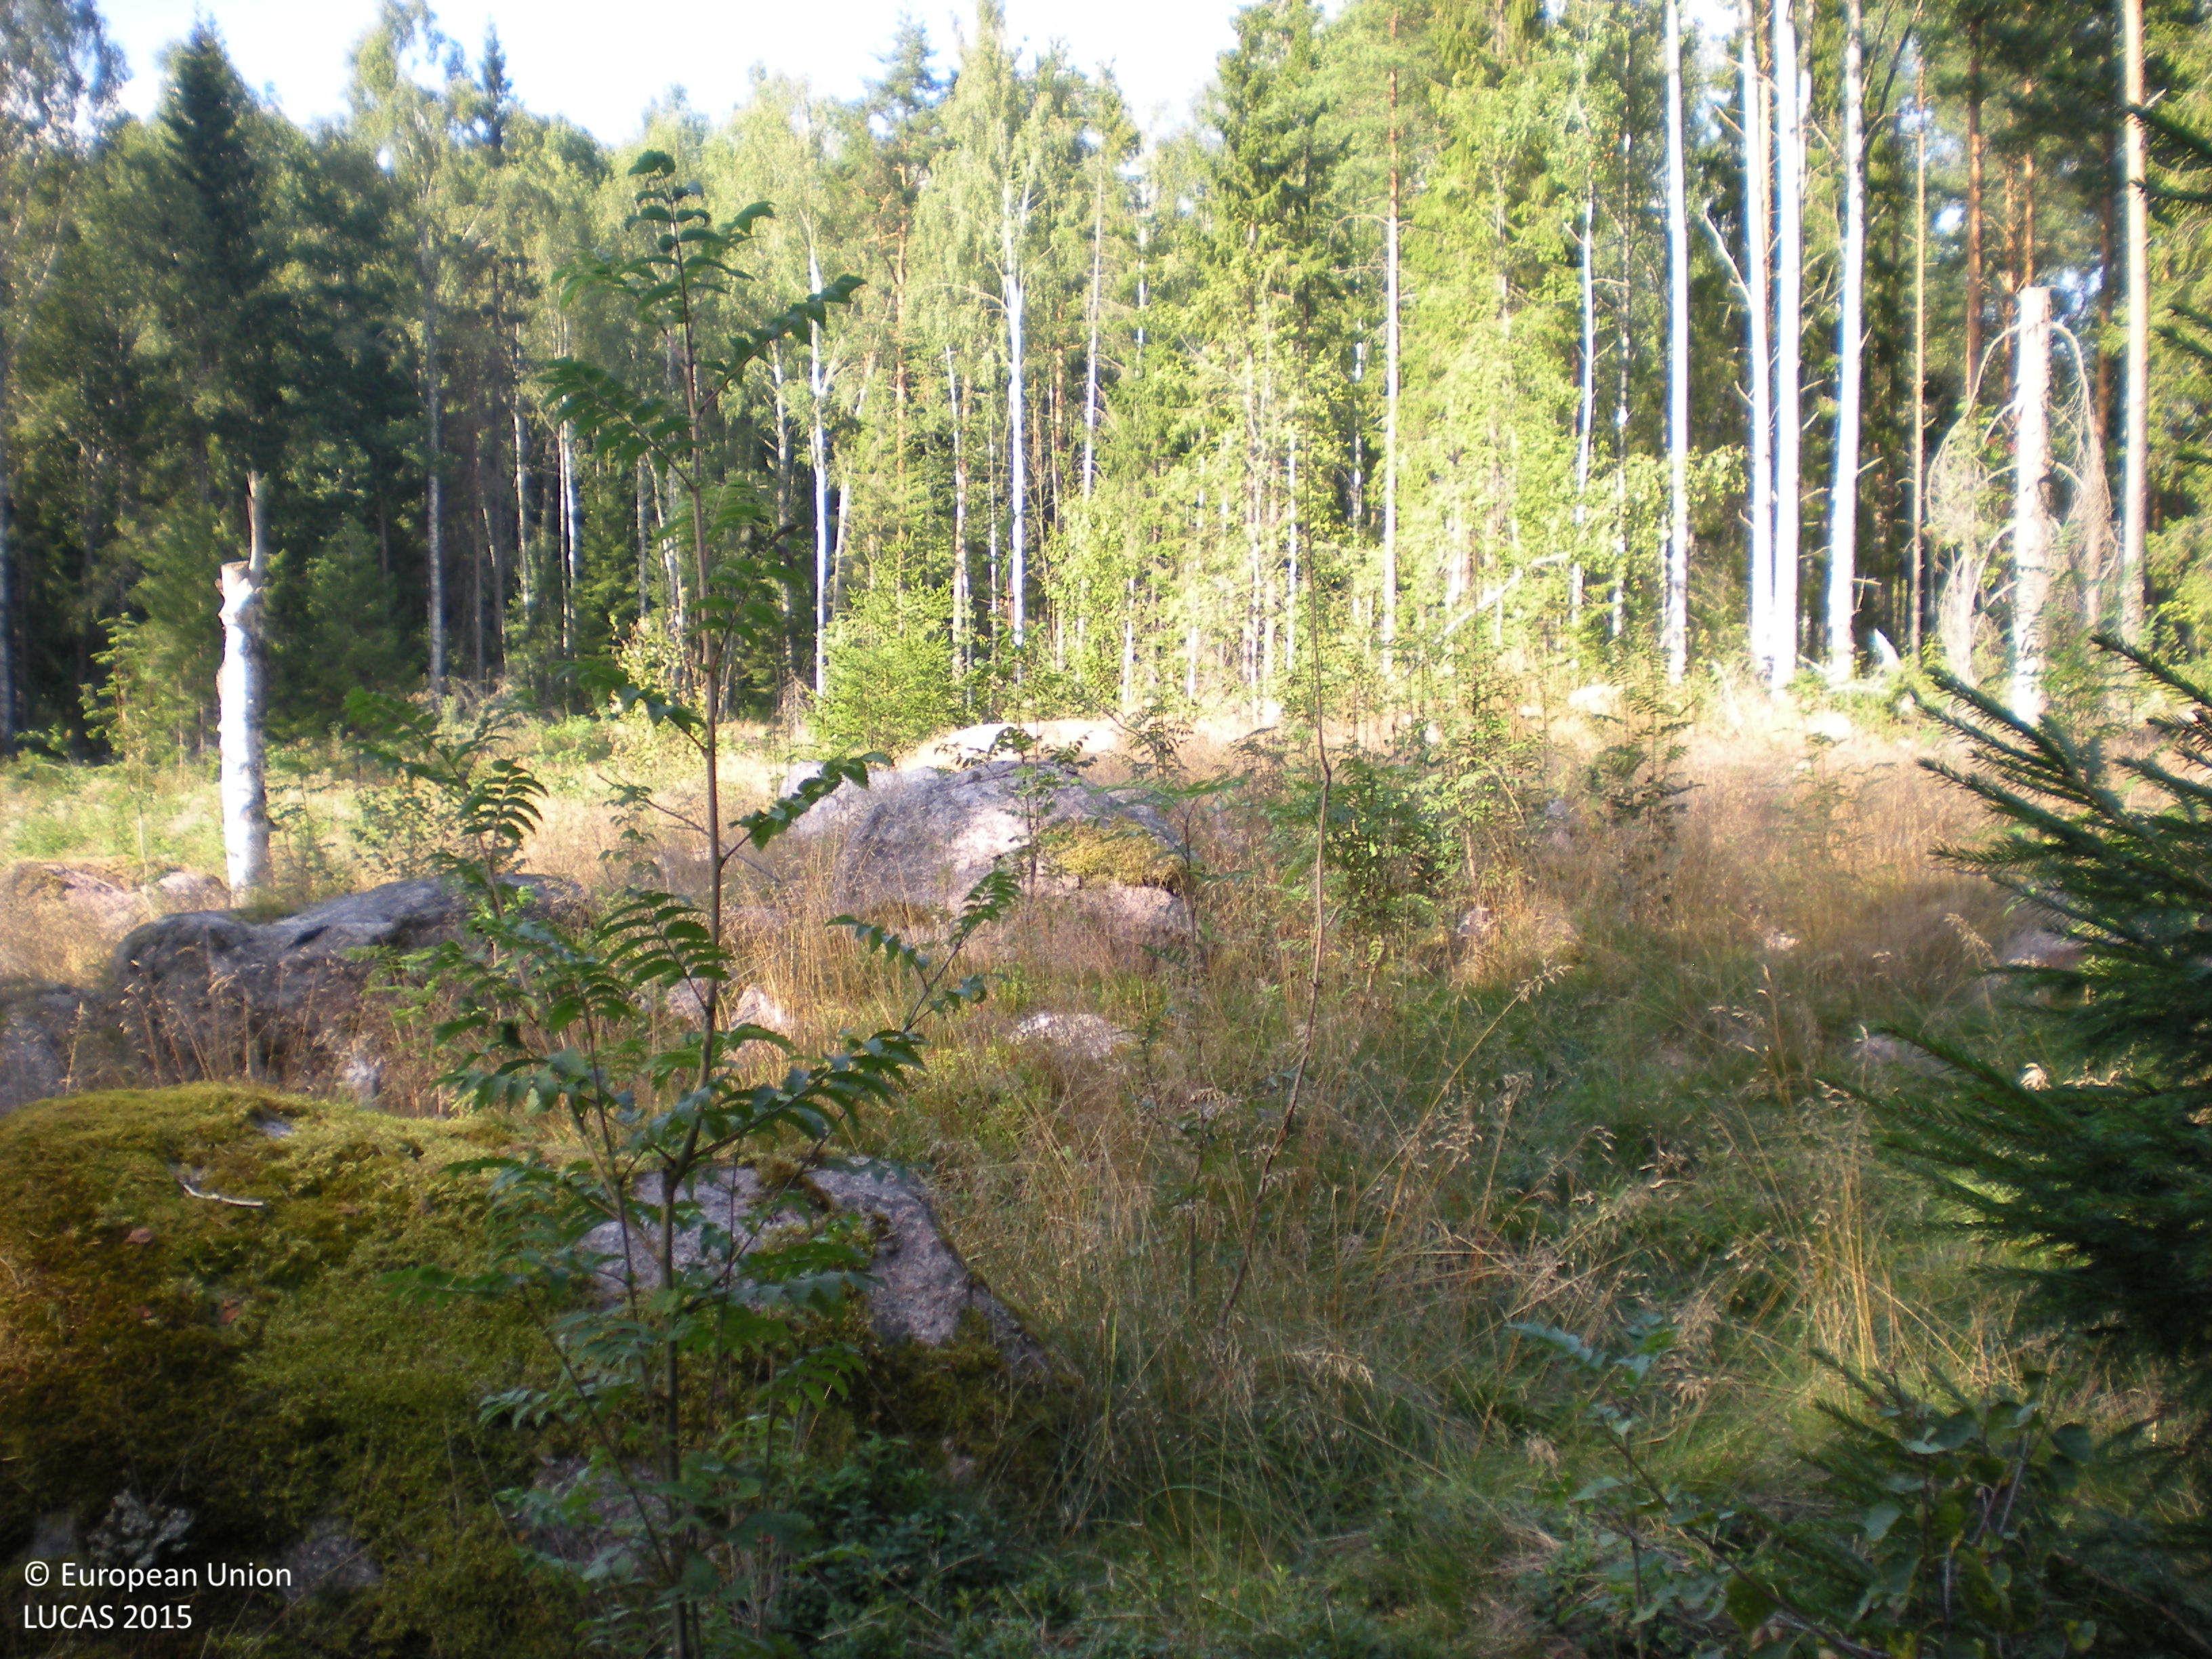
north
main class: Woodland
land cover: Spruce dominated coniferous woodland
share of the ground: 50 - 75 %
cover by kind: coniferous forest trees 50 %, shrubs 20 %, broadleaved forest trees 10 %, lichens and mosses 10 %, herbaceous plants 5 %, consolidated bare surface 5 %
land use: Forestry
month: August
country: SE
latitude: 60.3842
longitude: 17.0469
